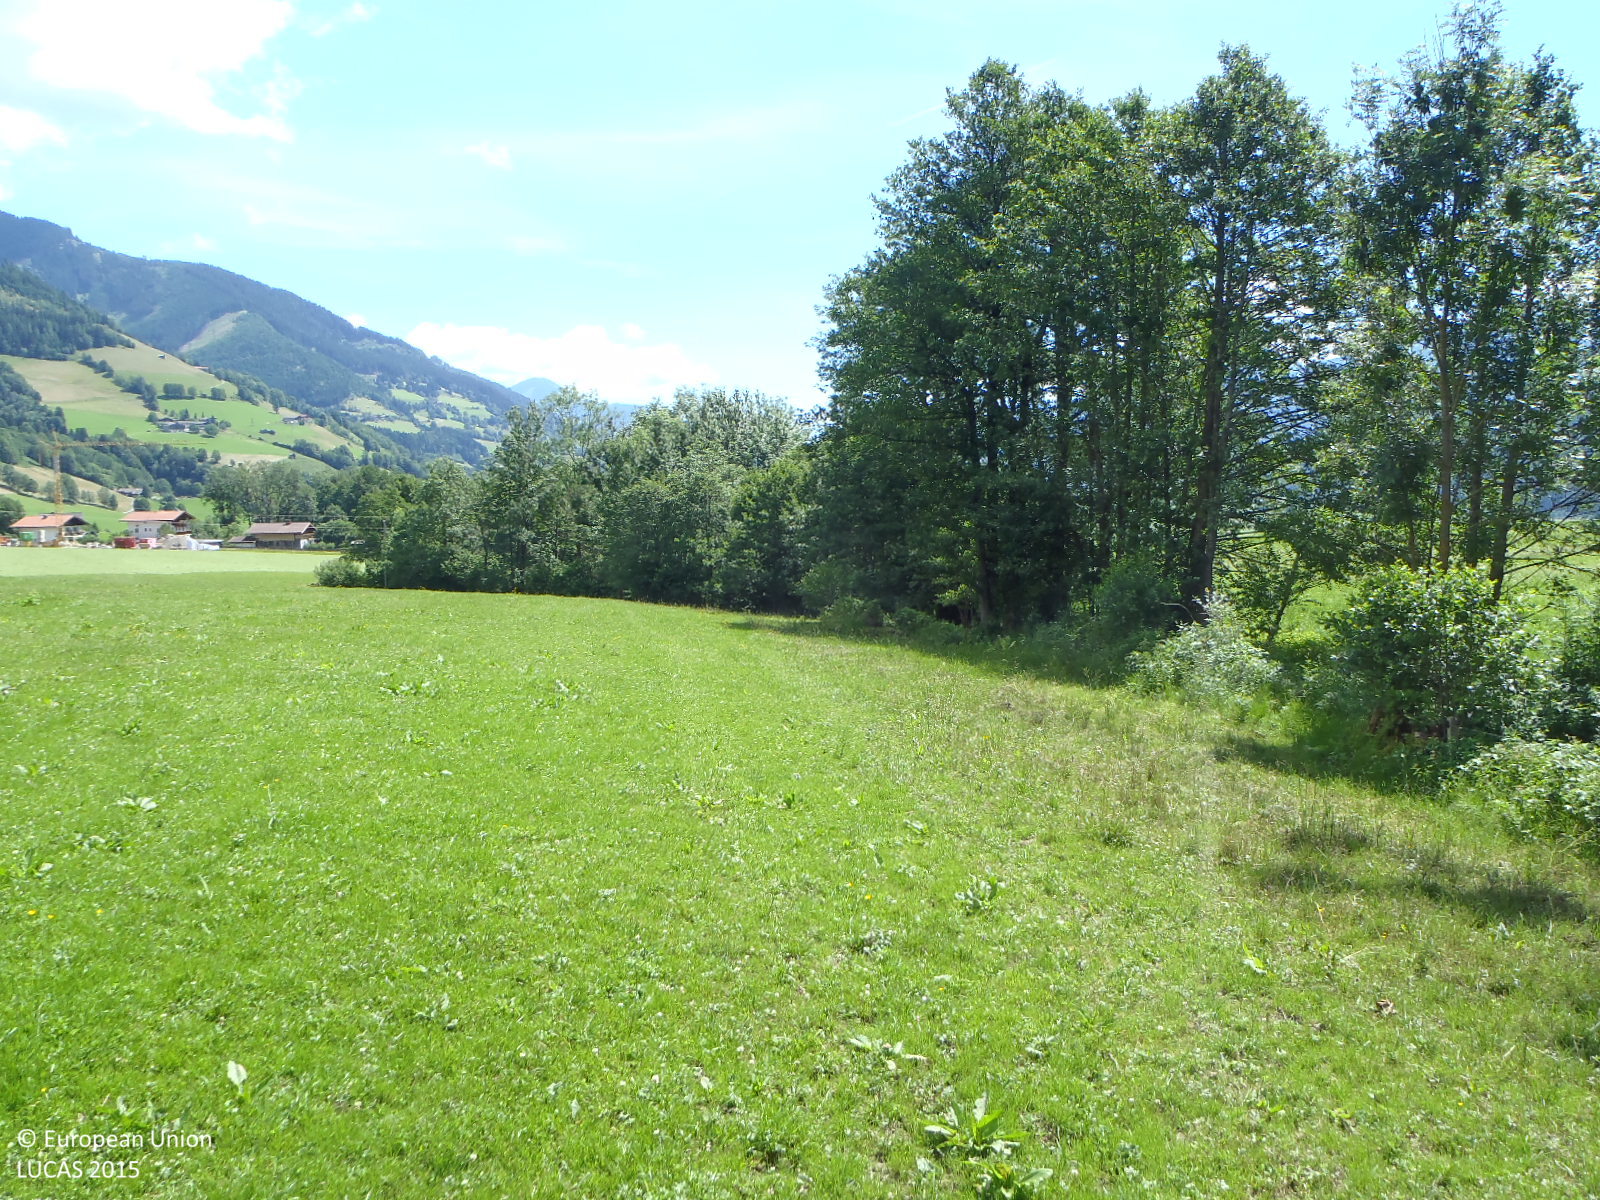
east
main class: Grassland
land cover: Grassland without tree/shrub cover
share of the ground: > 75 %
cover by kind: herbaceous plants 100 %
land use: Agriculture (excluding fallow land and kitchen gardens)
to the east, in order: Grassland without tree/shrub cover; Broadleaved woodland; Rivers and streams; Fences; Broadleaved woodland; Tracks; Grassland without tree/shrub cover; Electric lines; Grassland without tree/shrub cover; Tracks; Fences; Broadleaved woodland
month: June
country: AT
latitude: 47.2905
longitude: 12.6823
